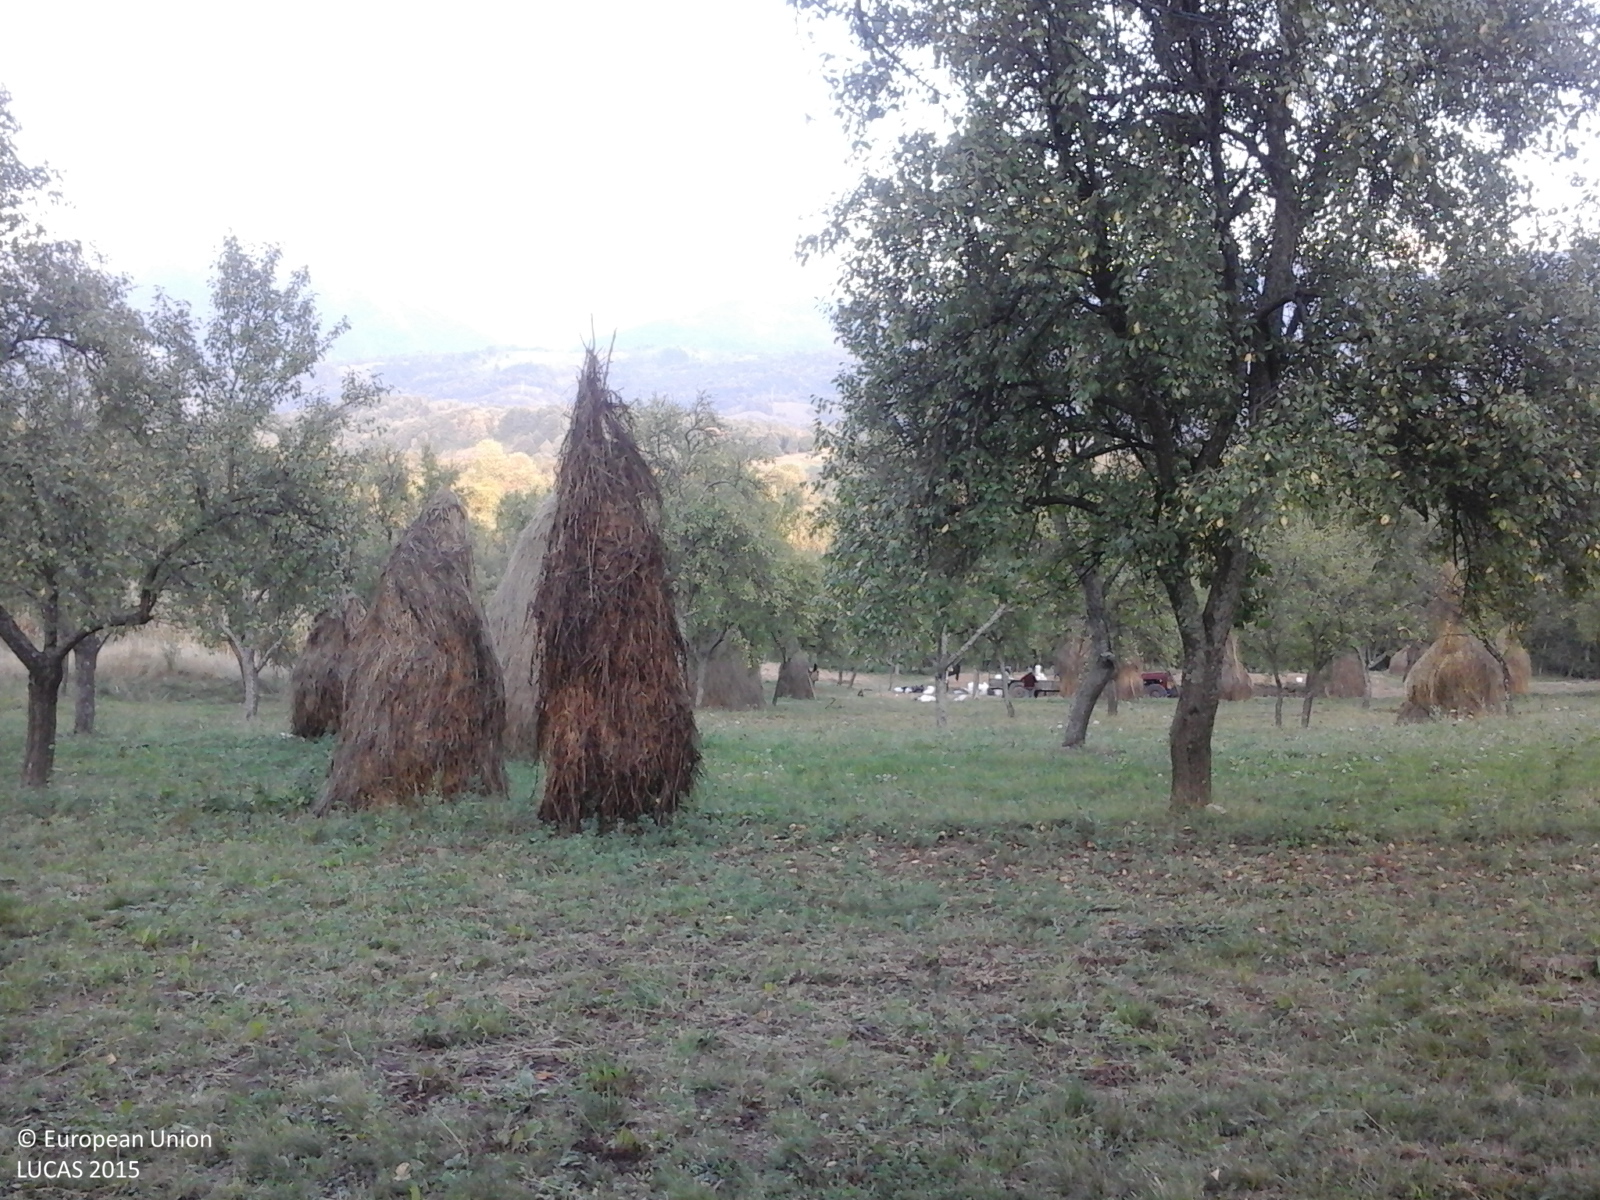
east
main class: Cropland
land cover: Other fruit trees and berries
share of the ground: > 75 %
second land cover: Grassland without tree/shrub cover
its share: > 75 %
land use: Agriculture (excluding fallow land and kitchen gardens)
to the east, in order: Other fruit trees and berries; Grassland without tree/shrub cover; Electric lines; Other fruit trees and berries; Potatoes; Tracks; Potatoes; Other fruit trees and berries
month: September
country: RO
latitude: 45.1301
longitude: 22.2841
